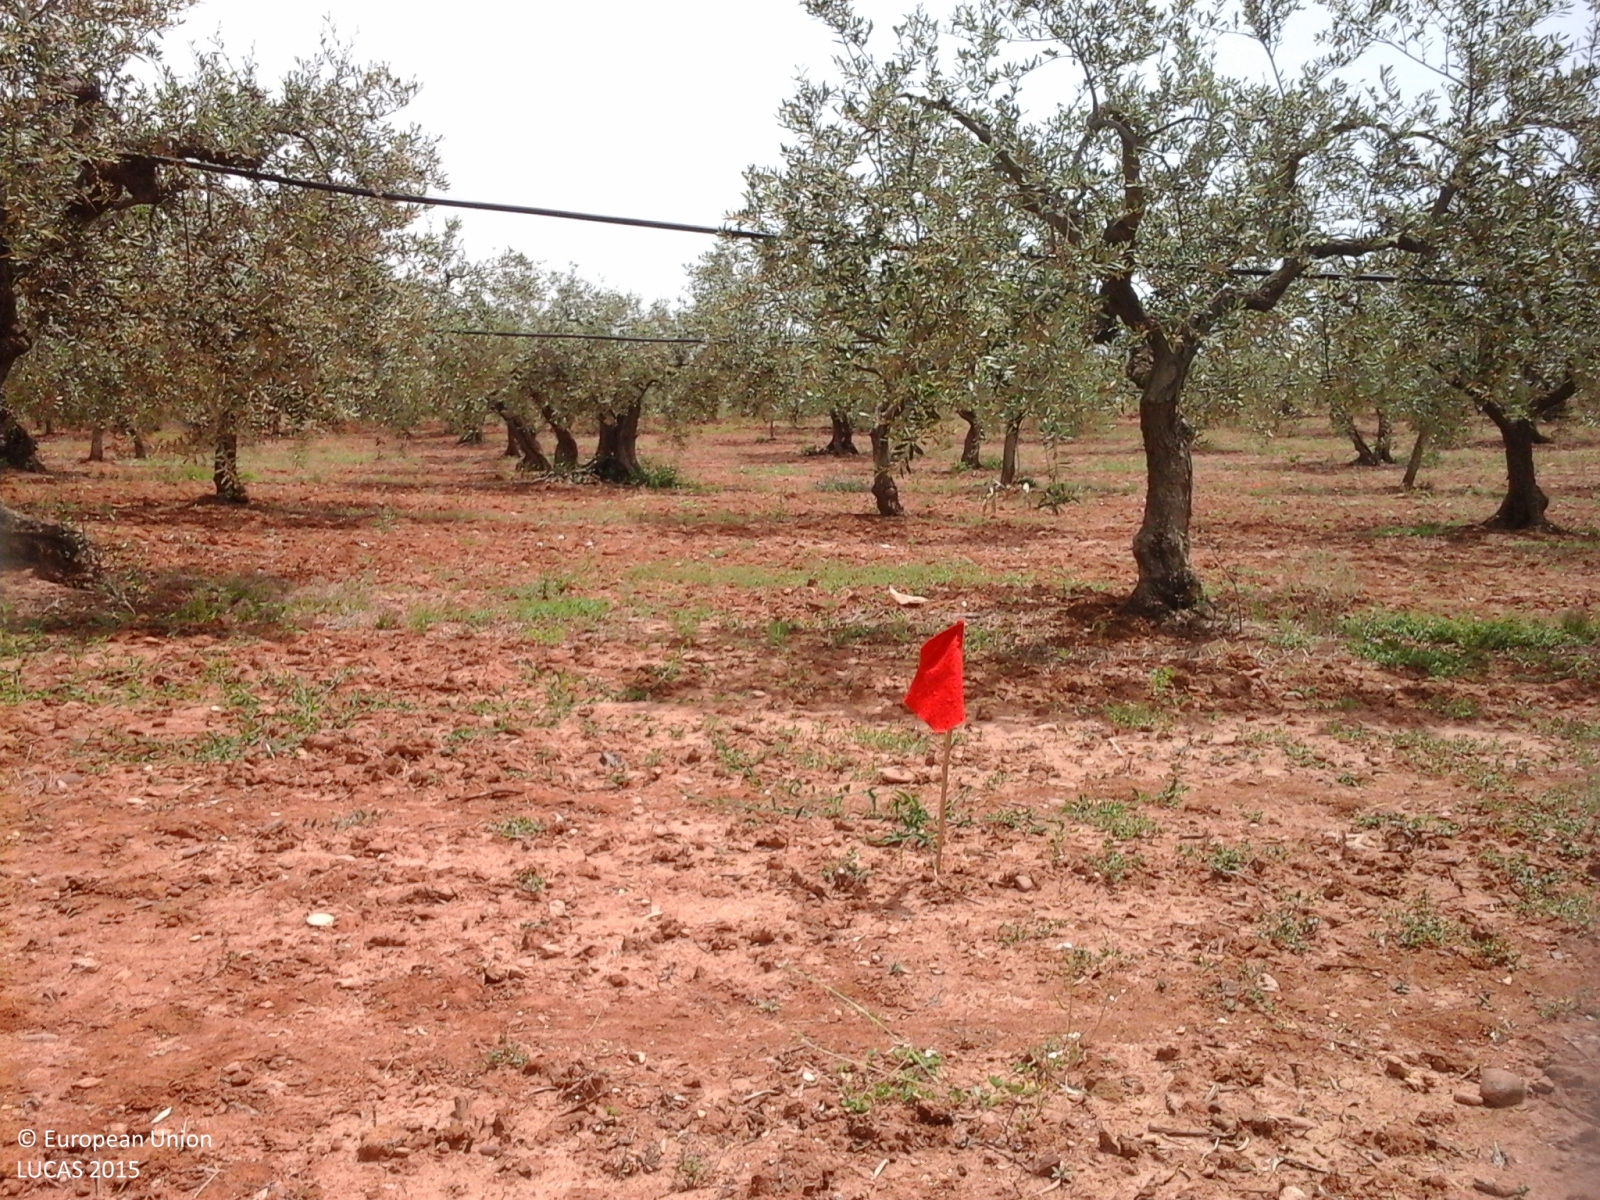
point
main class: Cropland
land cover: Olive groves
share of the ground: > 75 %
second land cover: Other bare soil
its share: > 75 %
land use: Agriculture (excluding fallow land and kitchen gardens)
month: May
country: IT
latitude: 37.6868
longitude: 12.8475
